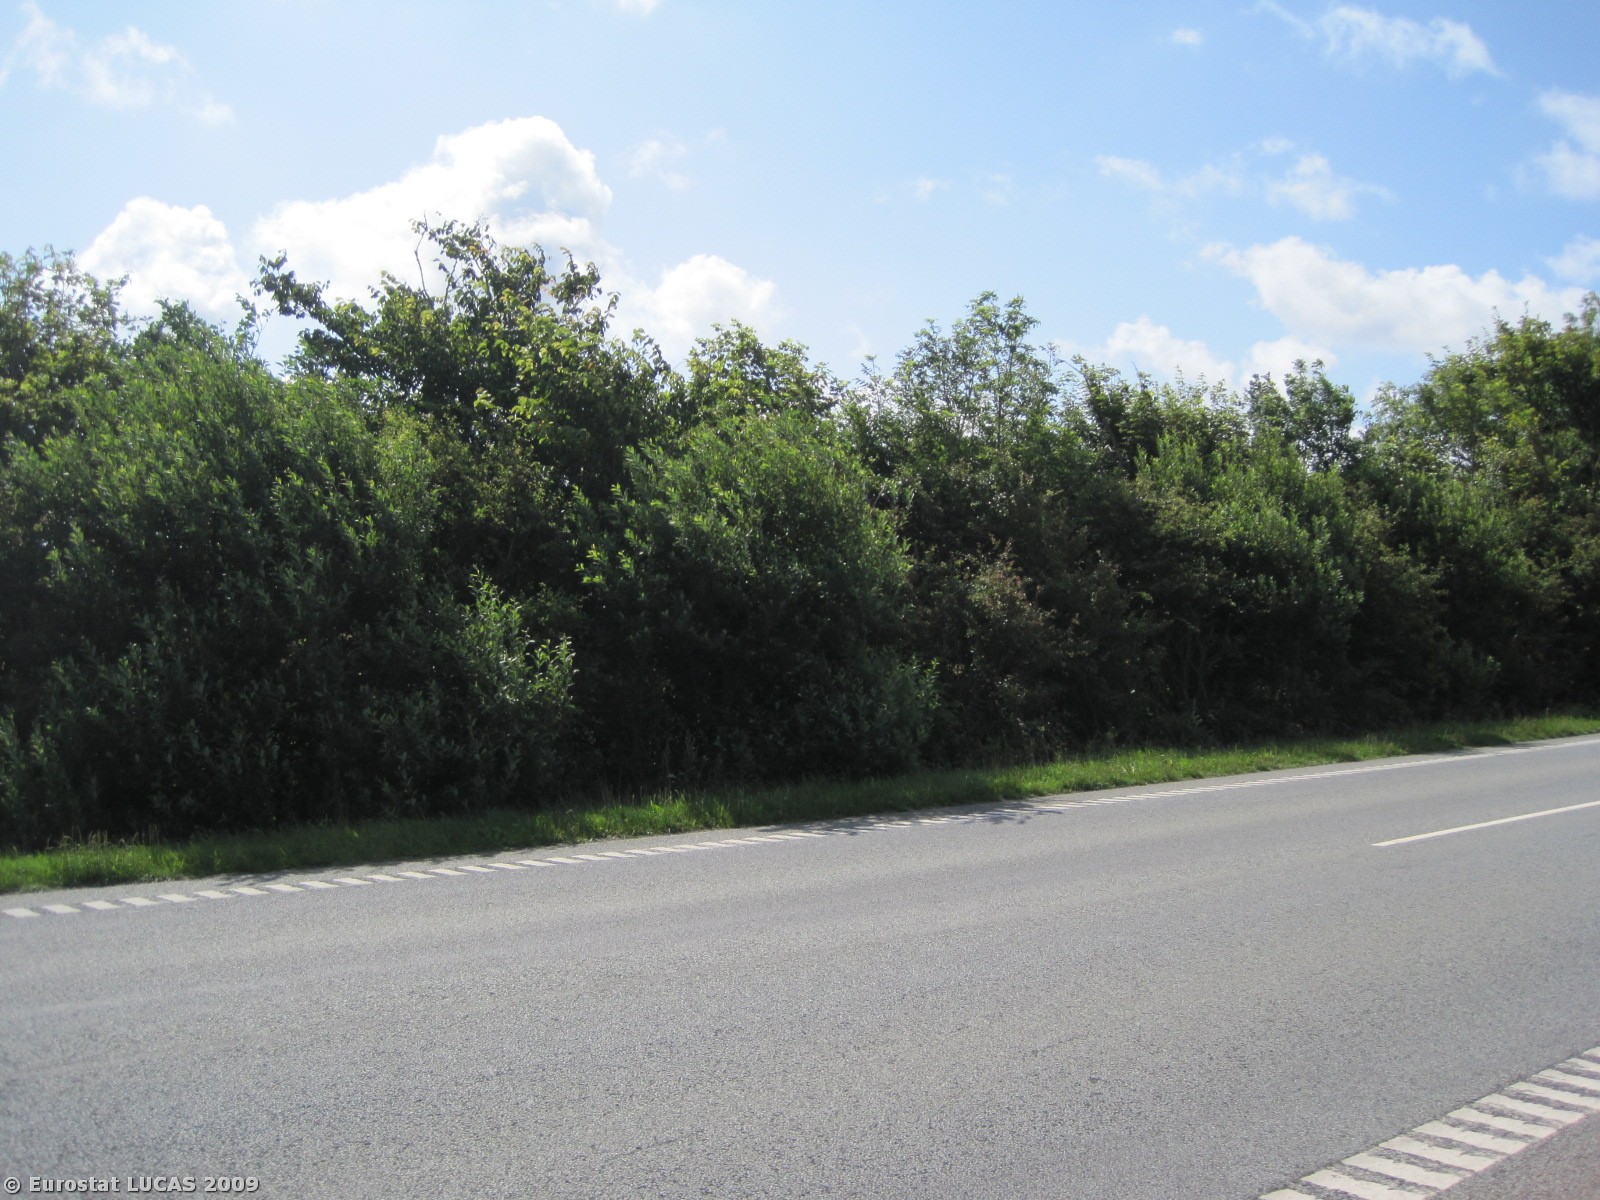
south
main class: Grassland
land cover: Grassland without tree/shrub cover
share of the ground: > 75 %
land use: Agriculture (excluding fallow land and kitchen gardens)
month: July
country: DK
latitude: 56.7174
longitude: 8.4172
